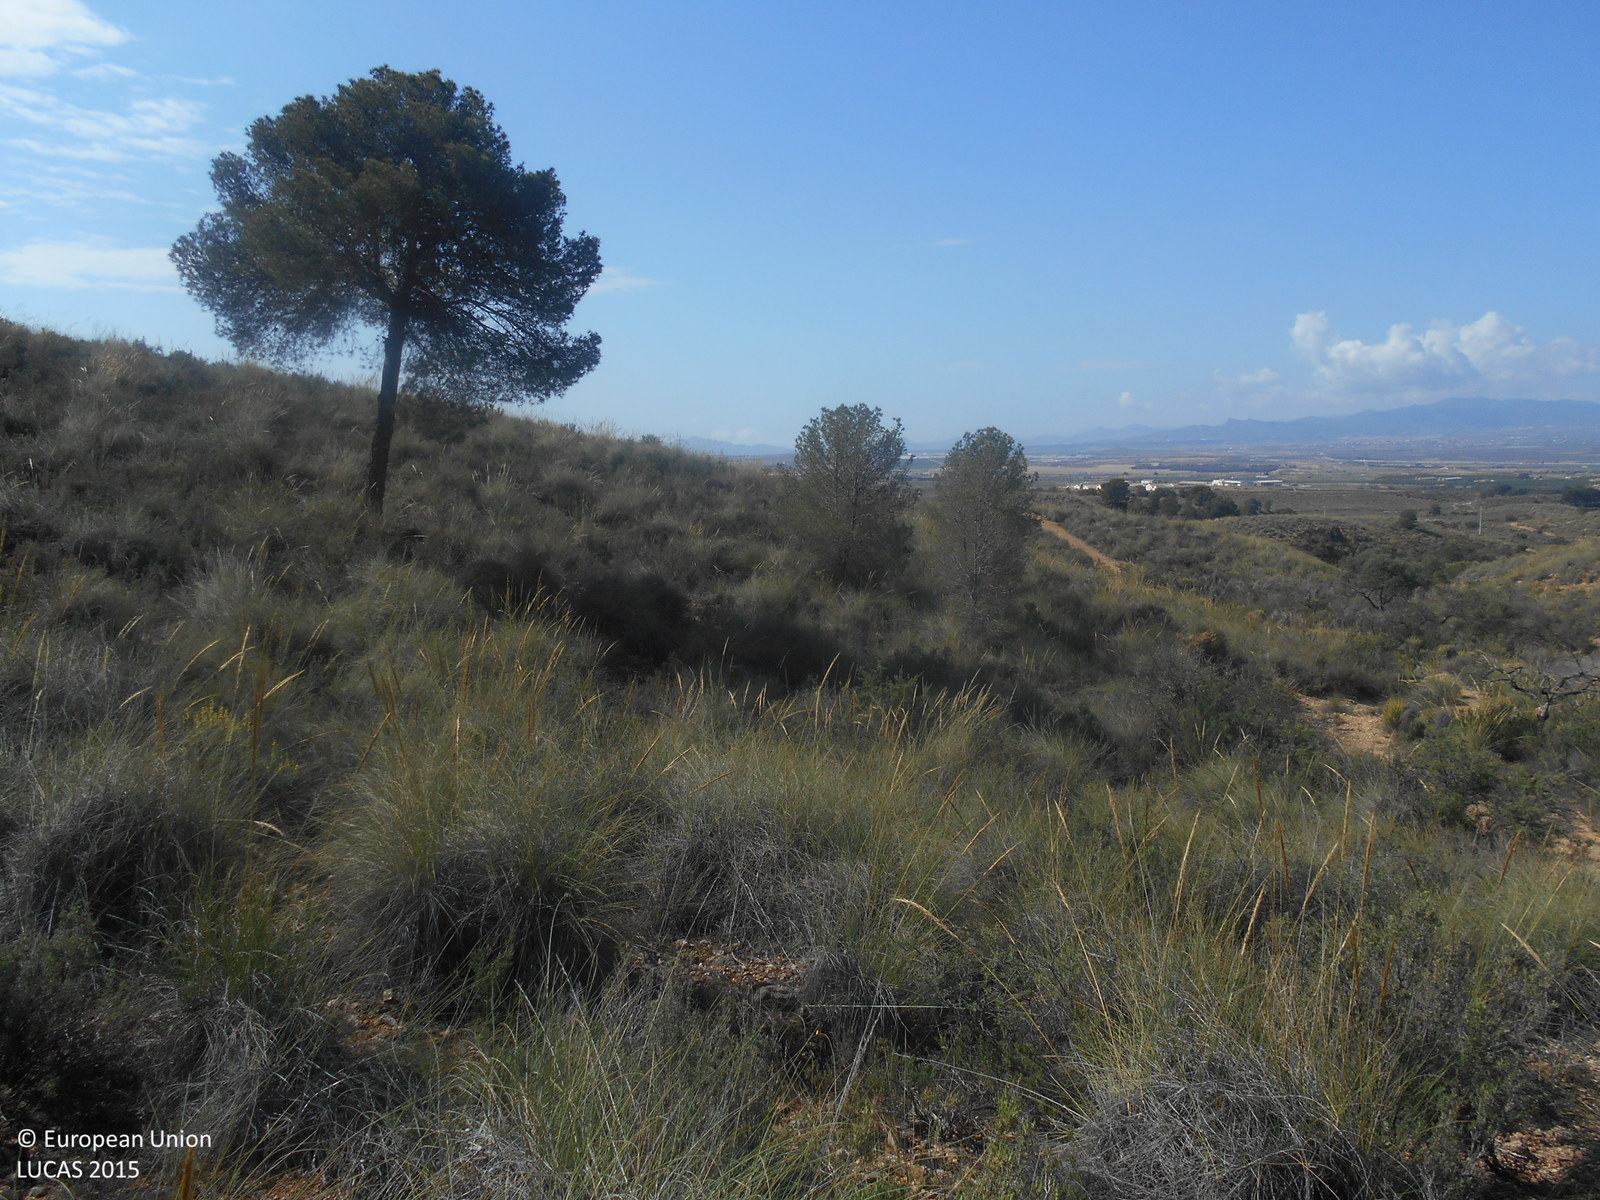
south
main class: Shrubland
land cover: Shrubland without tree cover
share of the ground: > 75 %
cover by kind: shrubs 80 %, unconsolidated bare surface 15 %, consolidated bare surface 5 %
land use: Semi-natural and natural areas not in use
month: April
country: ES
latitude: 37.8001
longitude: -1.3282
